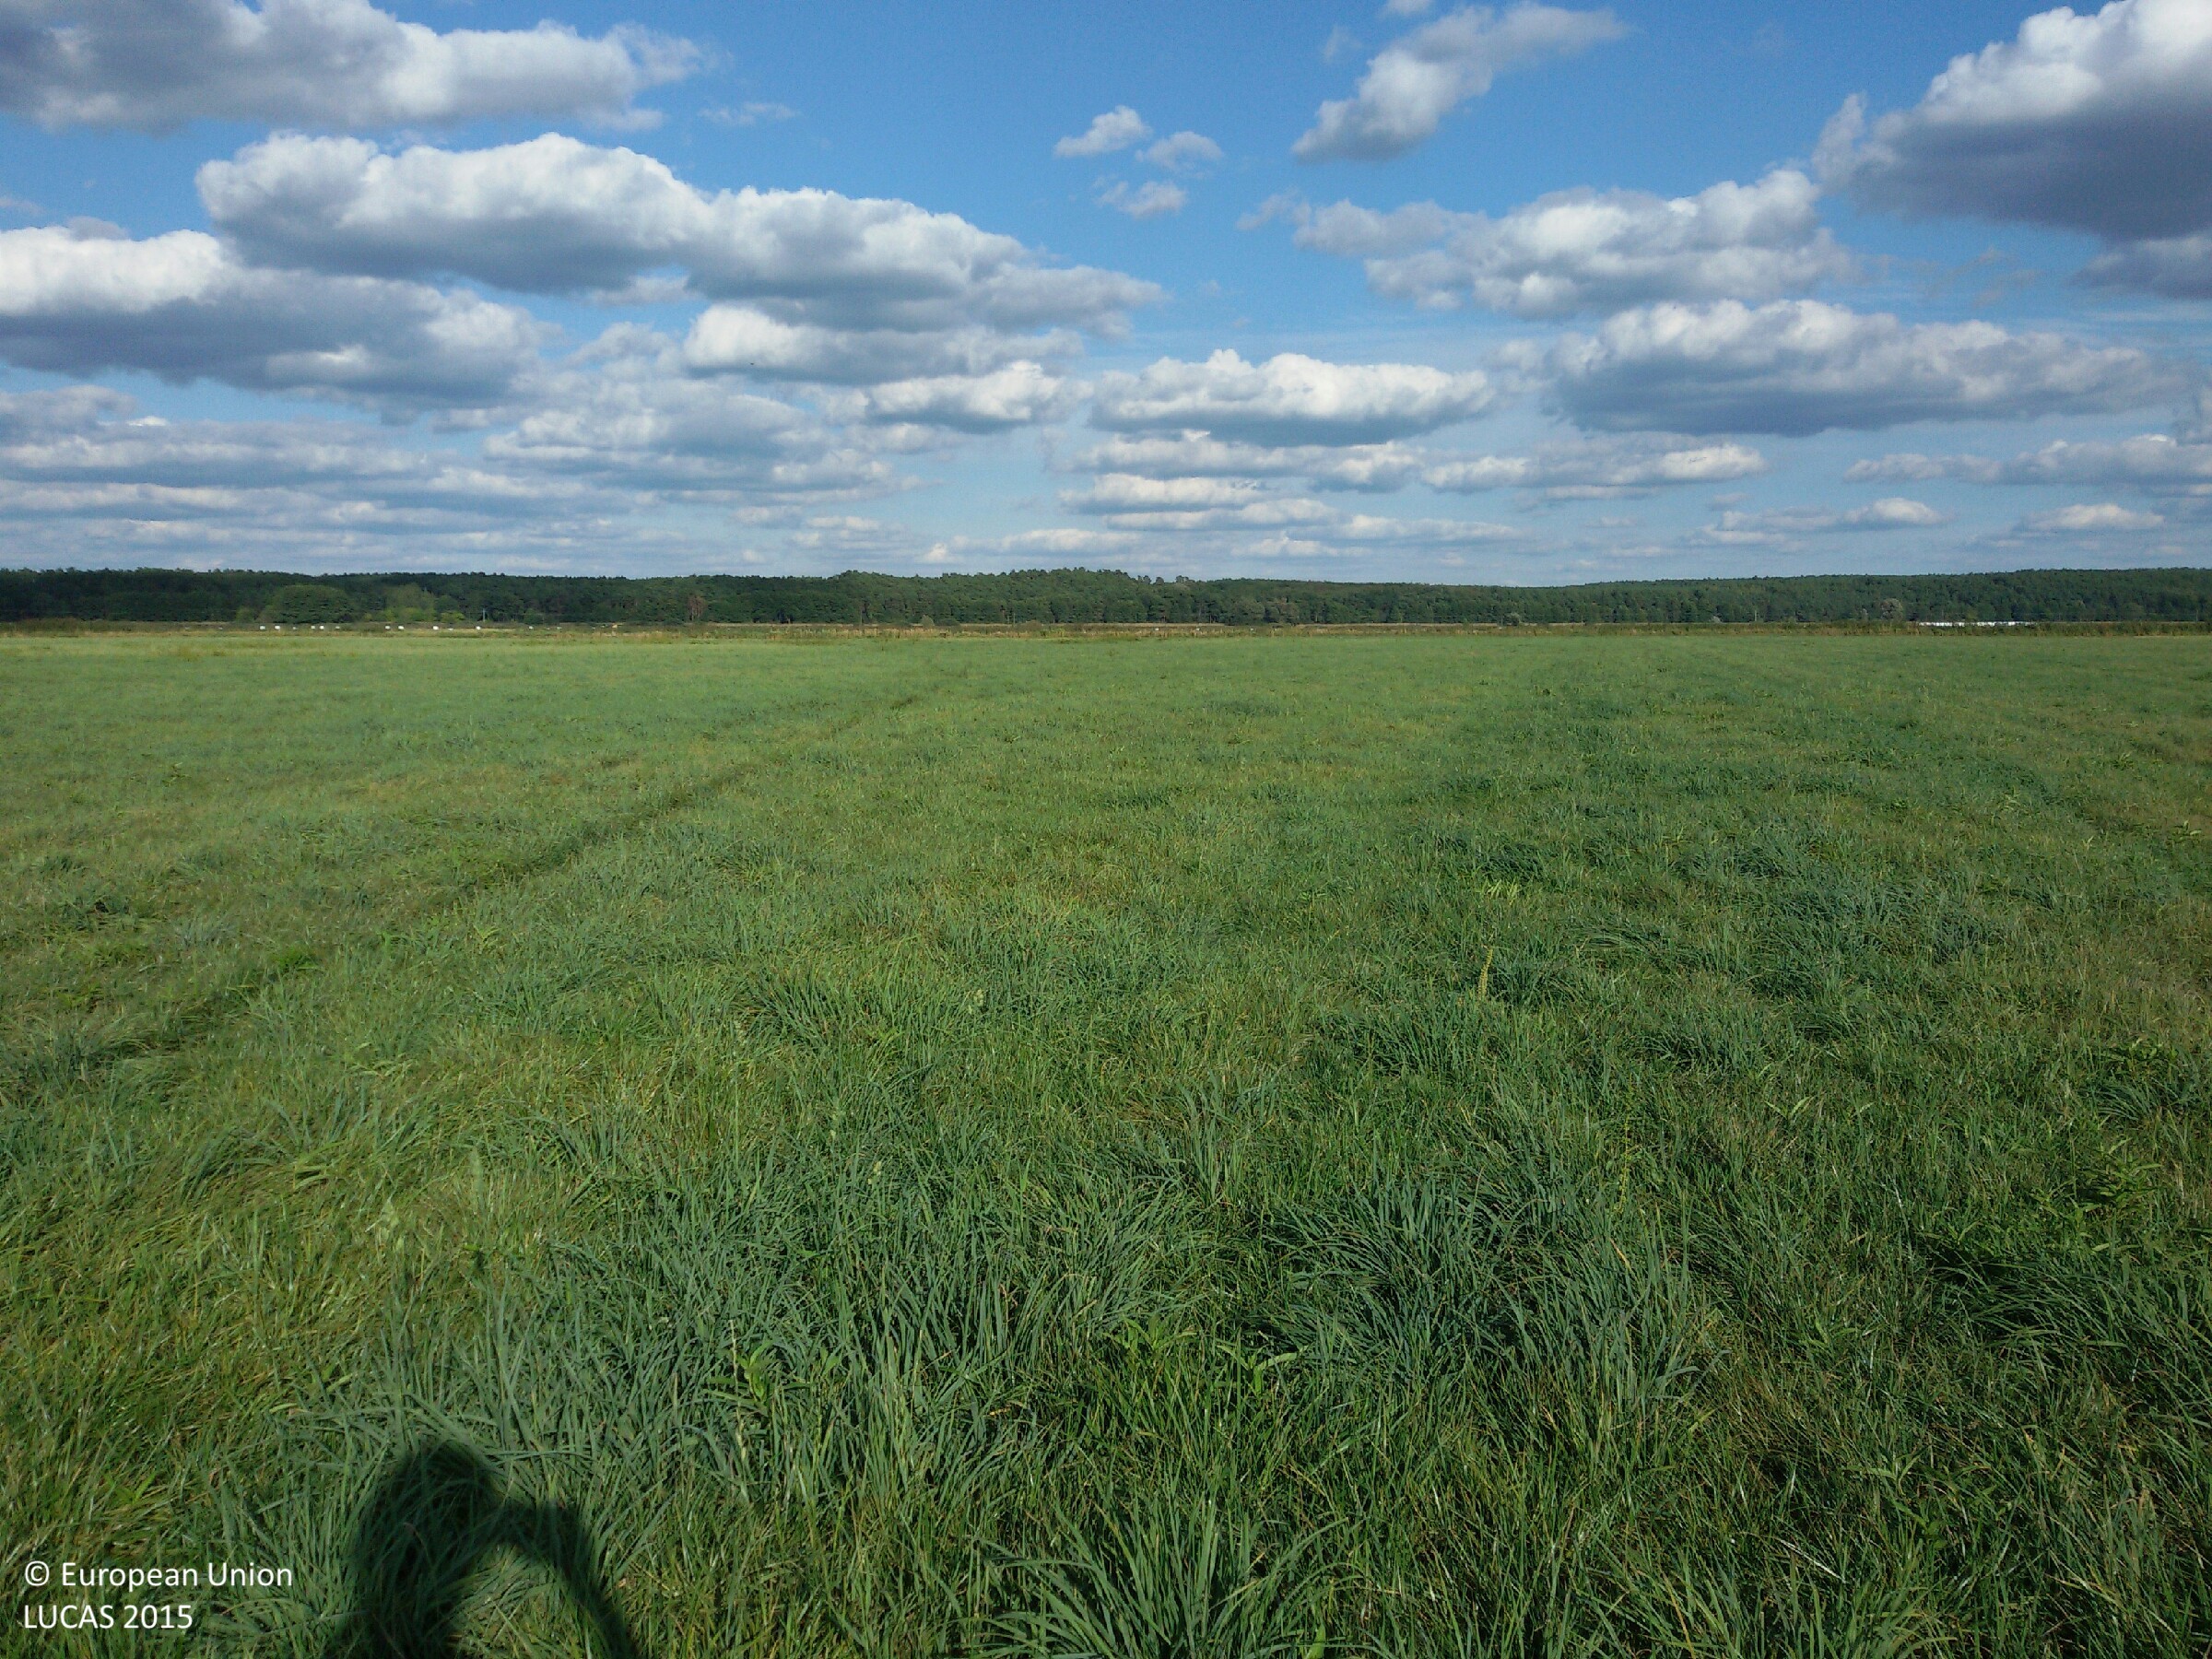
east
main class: Grassland
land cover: Grassland without tree/shrub cover
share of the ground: > 75 %
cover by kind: herbaceous plants 100 %
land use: Agriculture (excluding fallow land and kitchen gardens)
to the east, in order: Grassland without tree/shrub cover
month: September
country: PL
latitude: 52.2113
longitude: 14.7292
